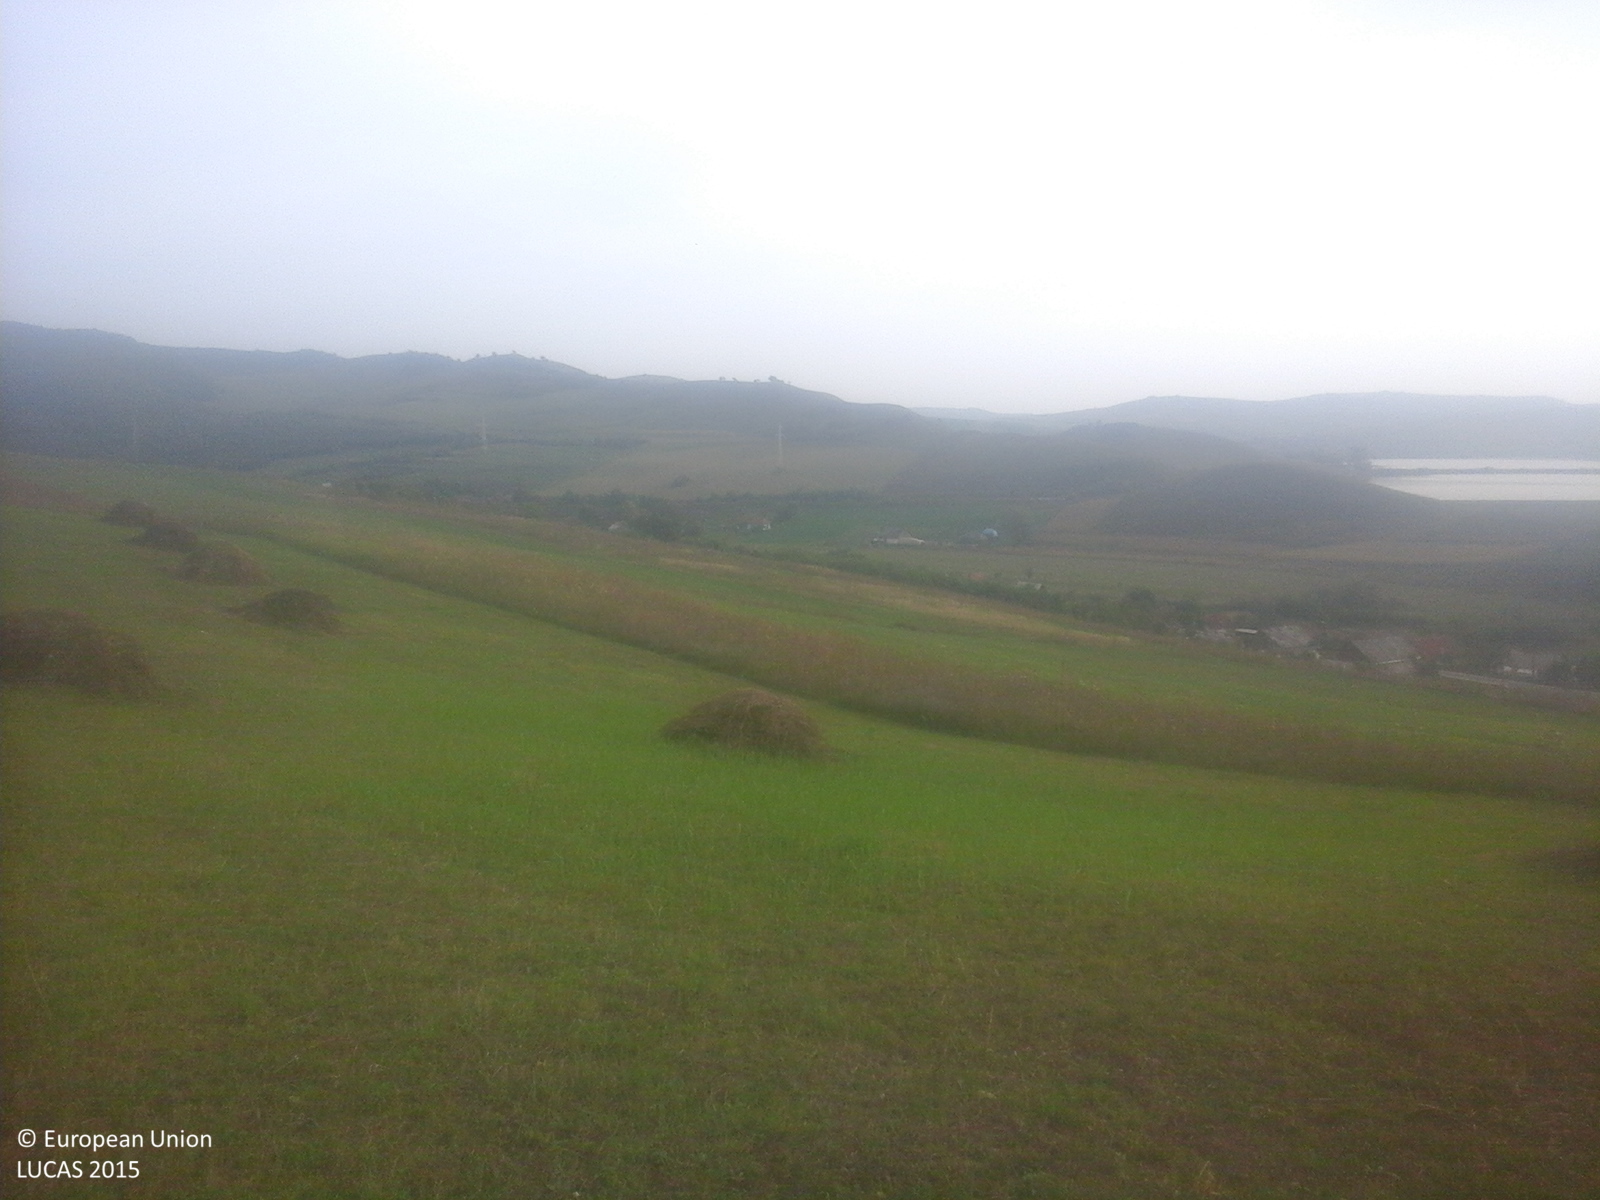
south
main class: Grassland
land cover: Grassland without tree/shrub cover
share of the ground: > 75 %
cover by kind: herbaceous plants 100 %
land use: Agriculture (excluding fallow land and kitchen gardens)
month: September
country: RO
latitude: 46.9542
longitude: 24.4508
